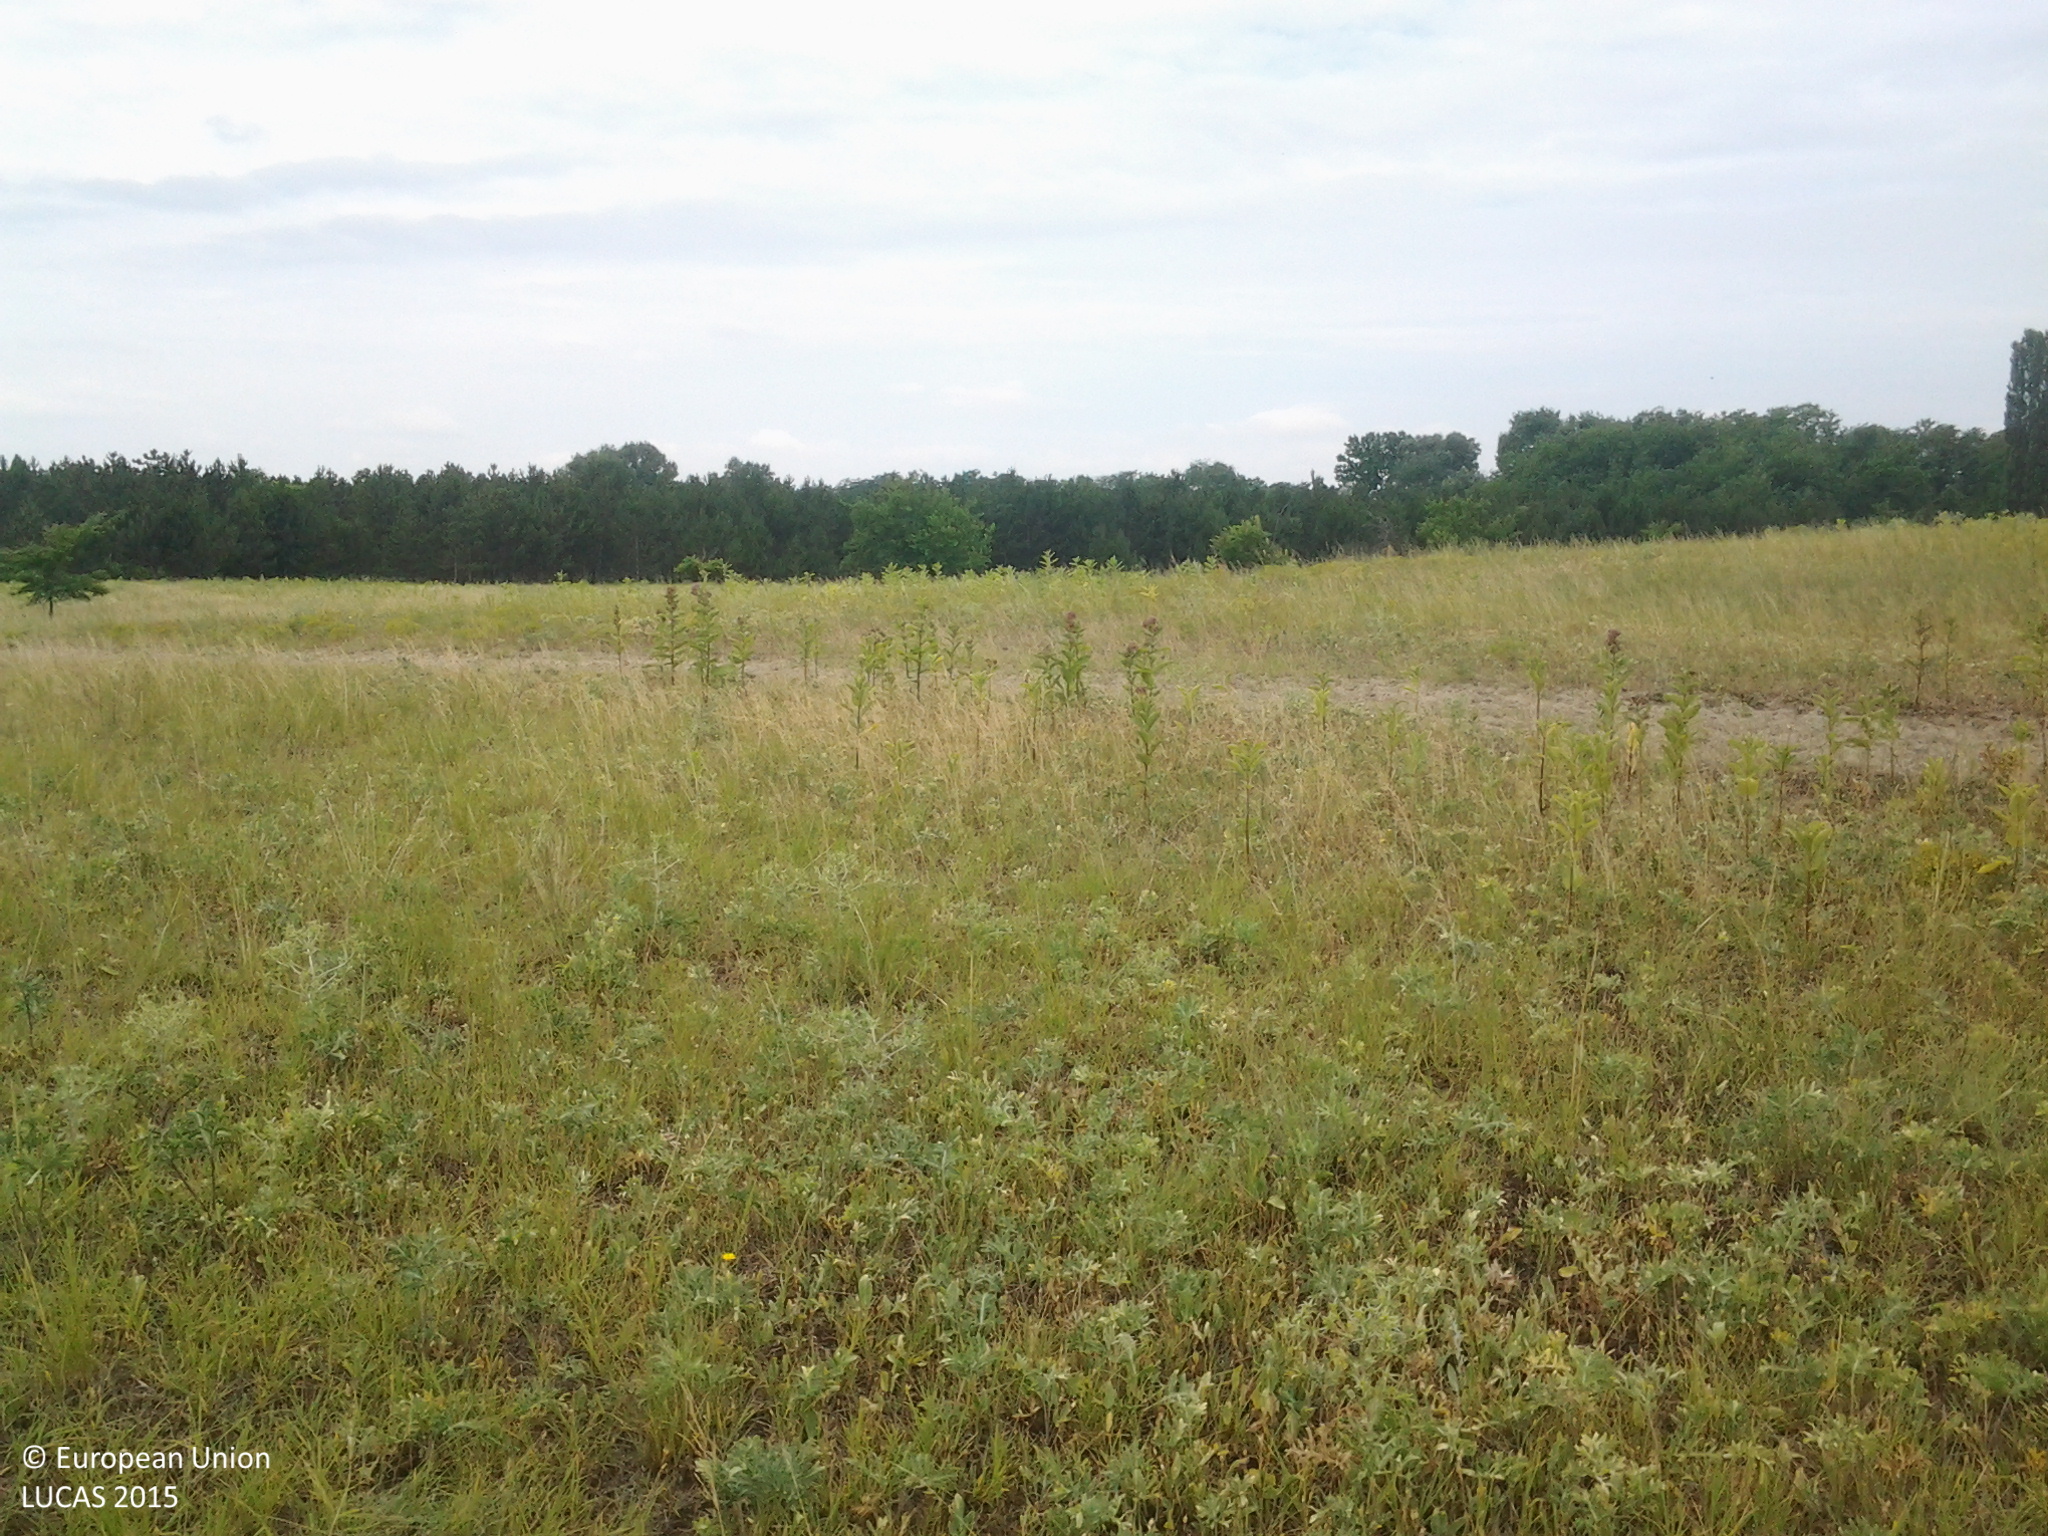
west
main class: Grassland
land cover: Spontaneously vegetated surfaces
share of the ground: > 75 %
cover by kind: herbaceous plants 95 %, shrubs 5 %
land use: Semi-natural and natural areas not in use
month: June
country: HU
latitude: 46.8345
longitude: 19.2864
